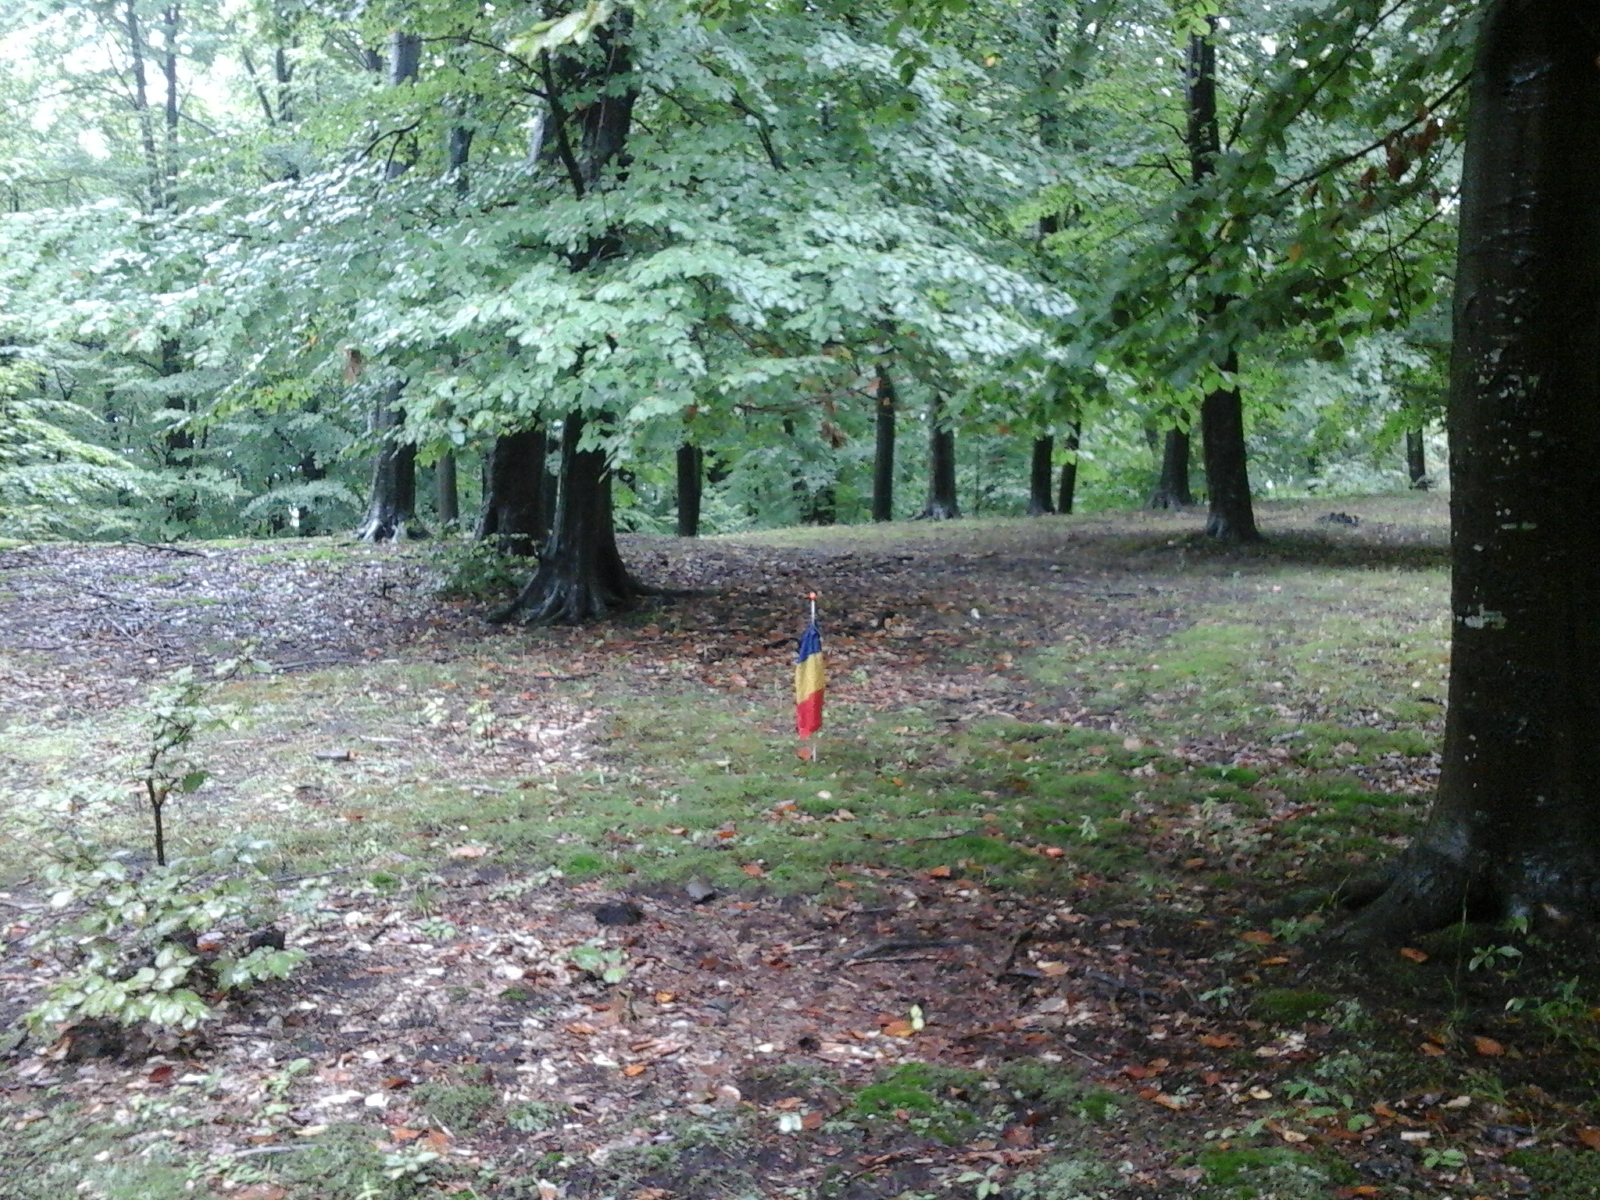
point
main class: Woodland
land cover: Broadleaved woodland
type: beech forest
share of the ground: > 75 %
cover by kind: broadleaved forest trees 100 %
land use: Forestry
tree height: > 5 m
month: September
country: RO
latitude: 45.0435
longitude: 23.7088
